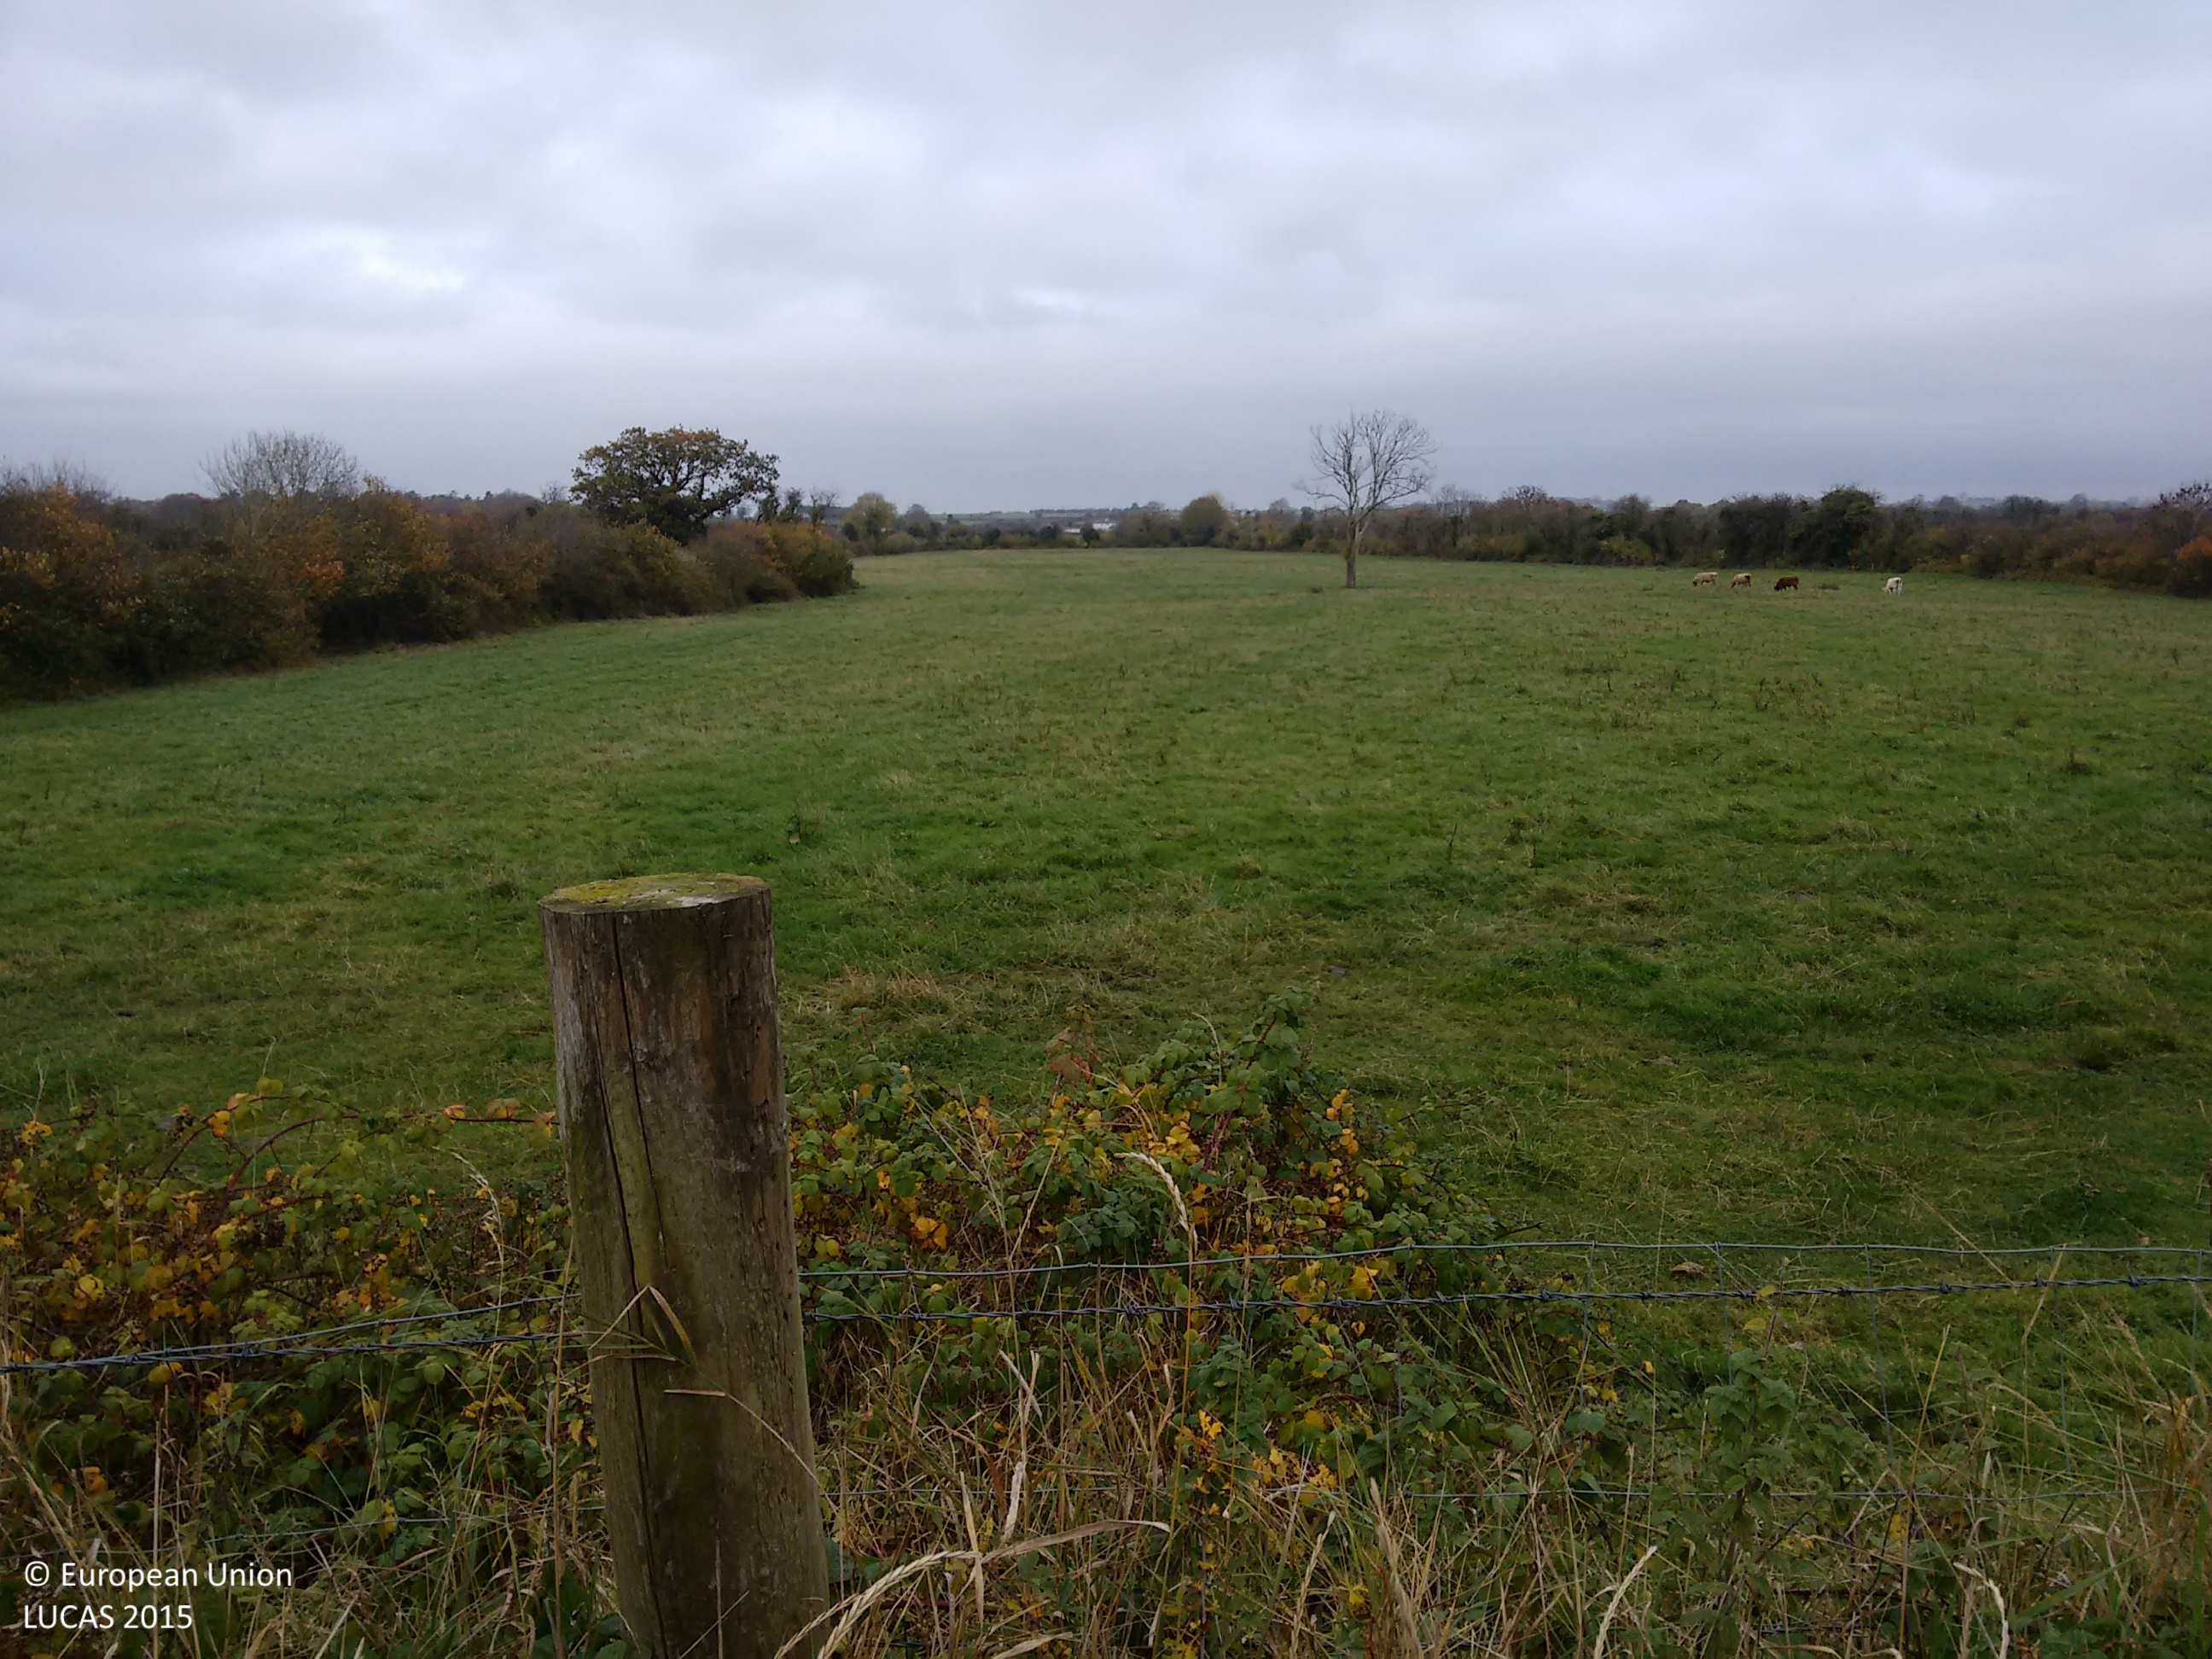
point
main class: Grassland
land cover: Grassland without tree/shrub cover
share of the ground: > 75 %
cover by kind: herbaceous plants 100 %
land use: Agriculture (excluding fallow land and kitchen gardens)
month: October
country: IE
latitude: 53.2769
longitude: -7.6030
